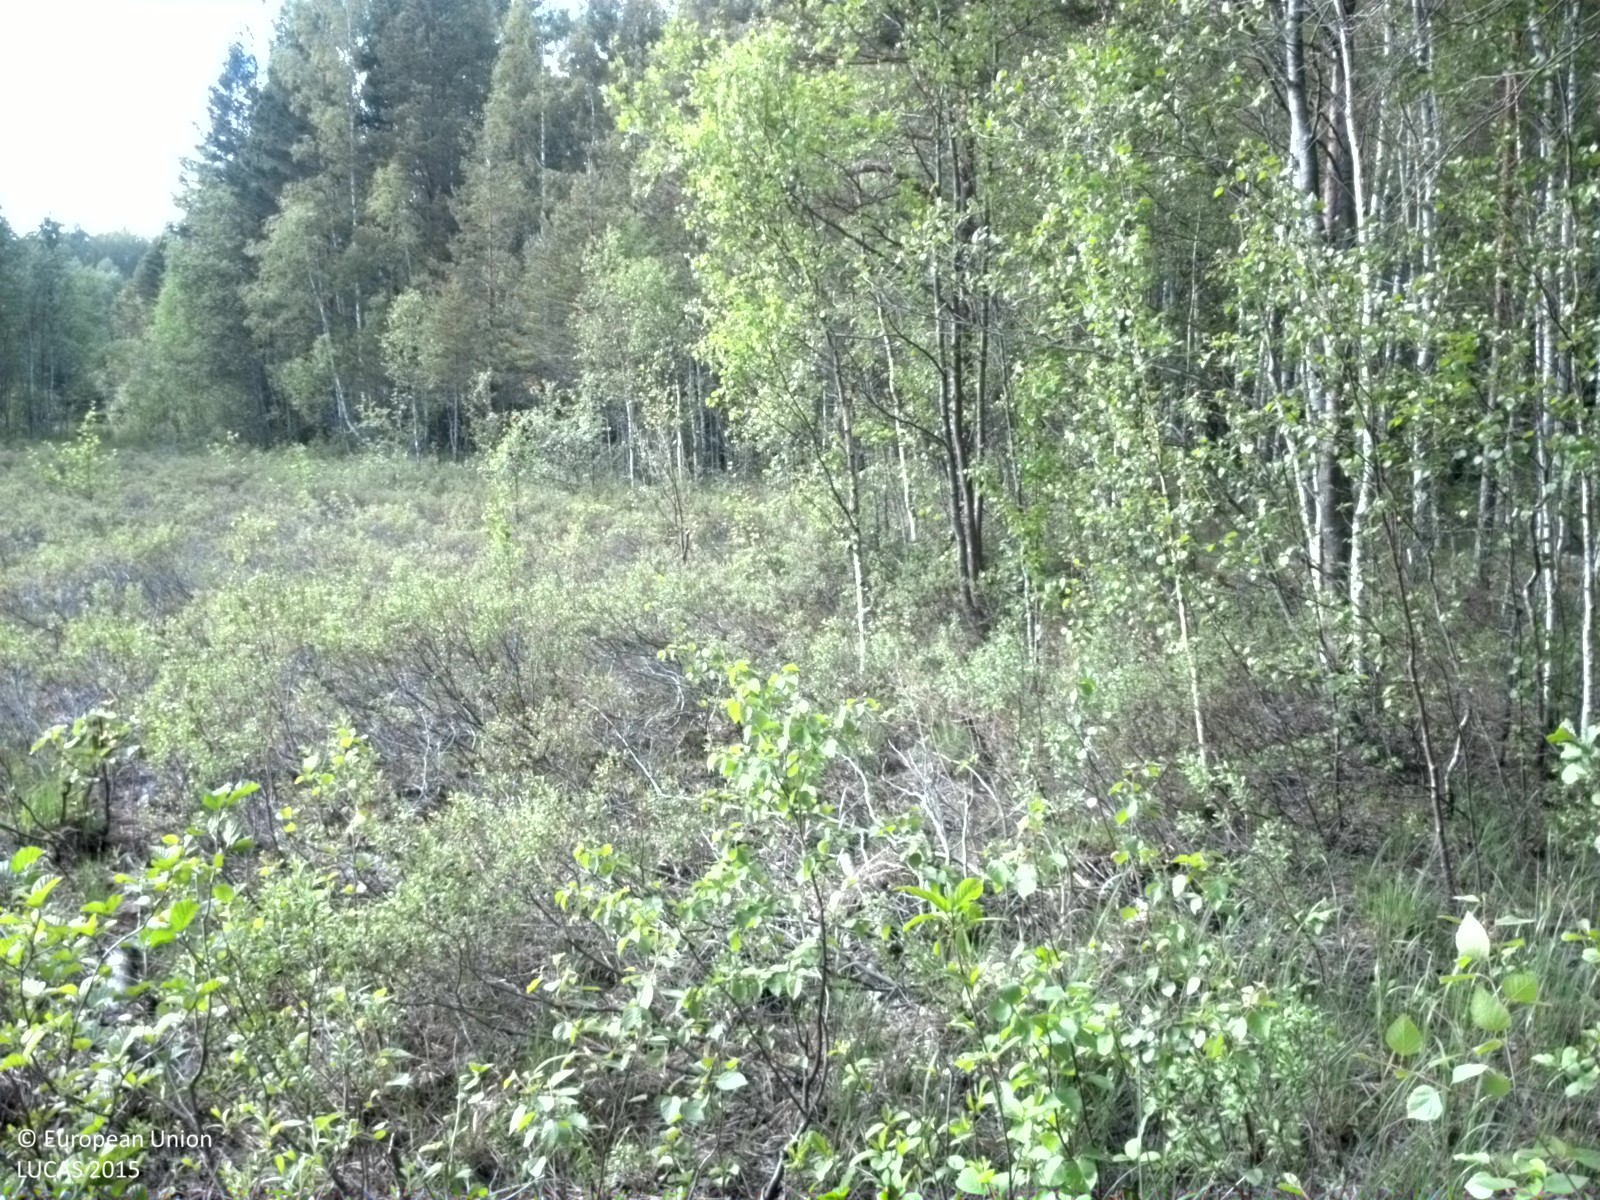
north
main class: Woodland
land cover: Broadleaved woodland
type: non-riverine alder, birch or aspen forest
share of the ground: 25 - 50 %
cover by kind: broadleaved forest trees 45 %, herbaceous plants 30 %, shrubs 15 %, coniferous forest trees 5 %, lichens and mosses 5 %
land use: Forestry
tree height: > 5 m
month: June
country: SE
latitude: 60.3036
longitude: 17.2113
